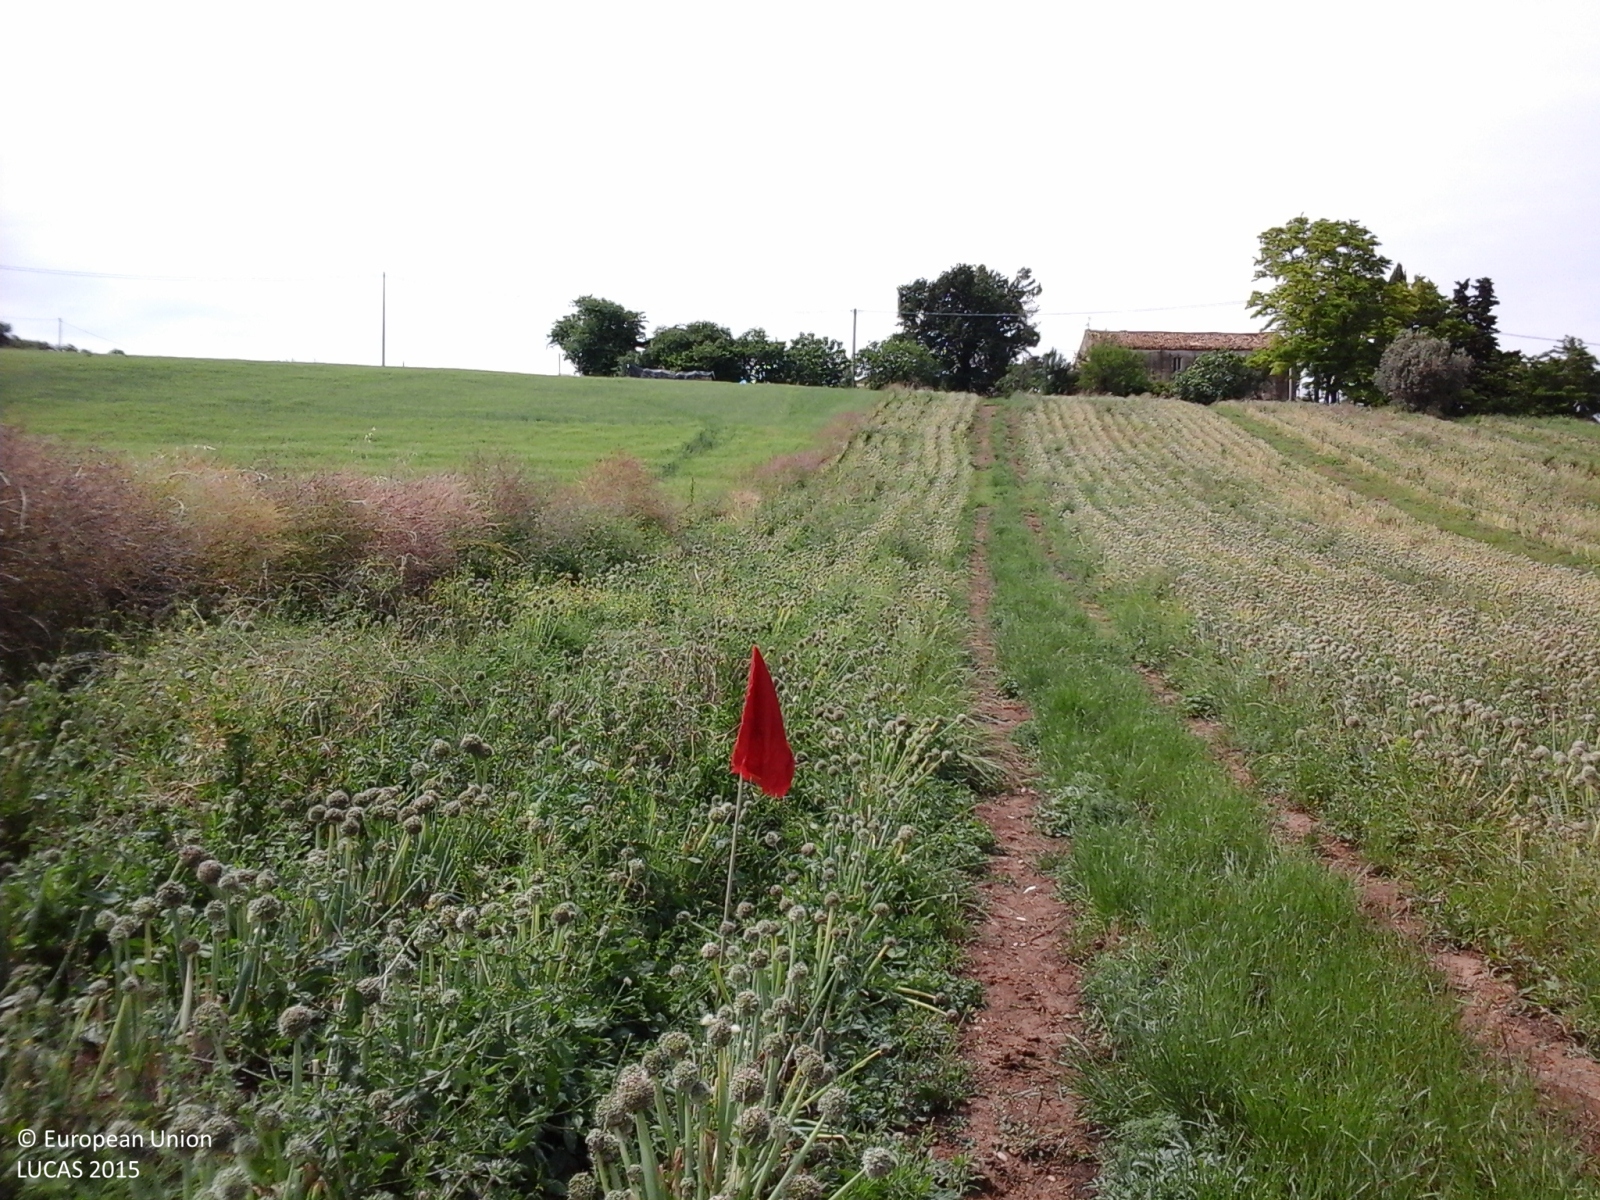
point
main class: Cropland
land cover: Other root crops
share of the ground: > 75 %
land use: Agriculture (excluding fallow land and kitchen gardens)
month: May
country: IT
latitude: 43.0145
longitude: 13.8547
